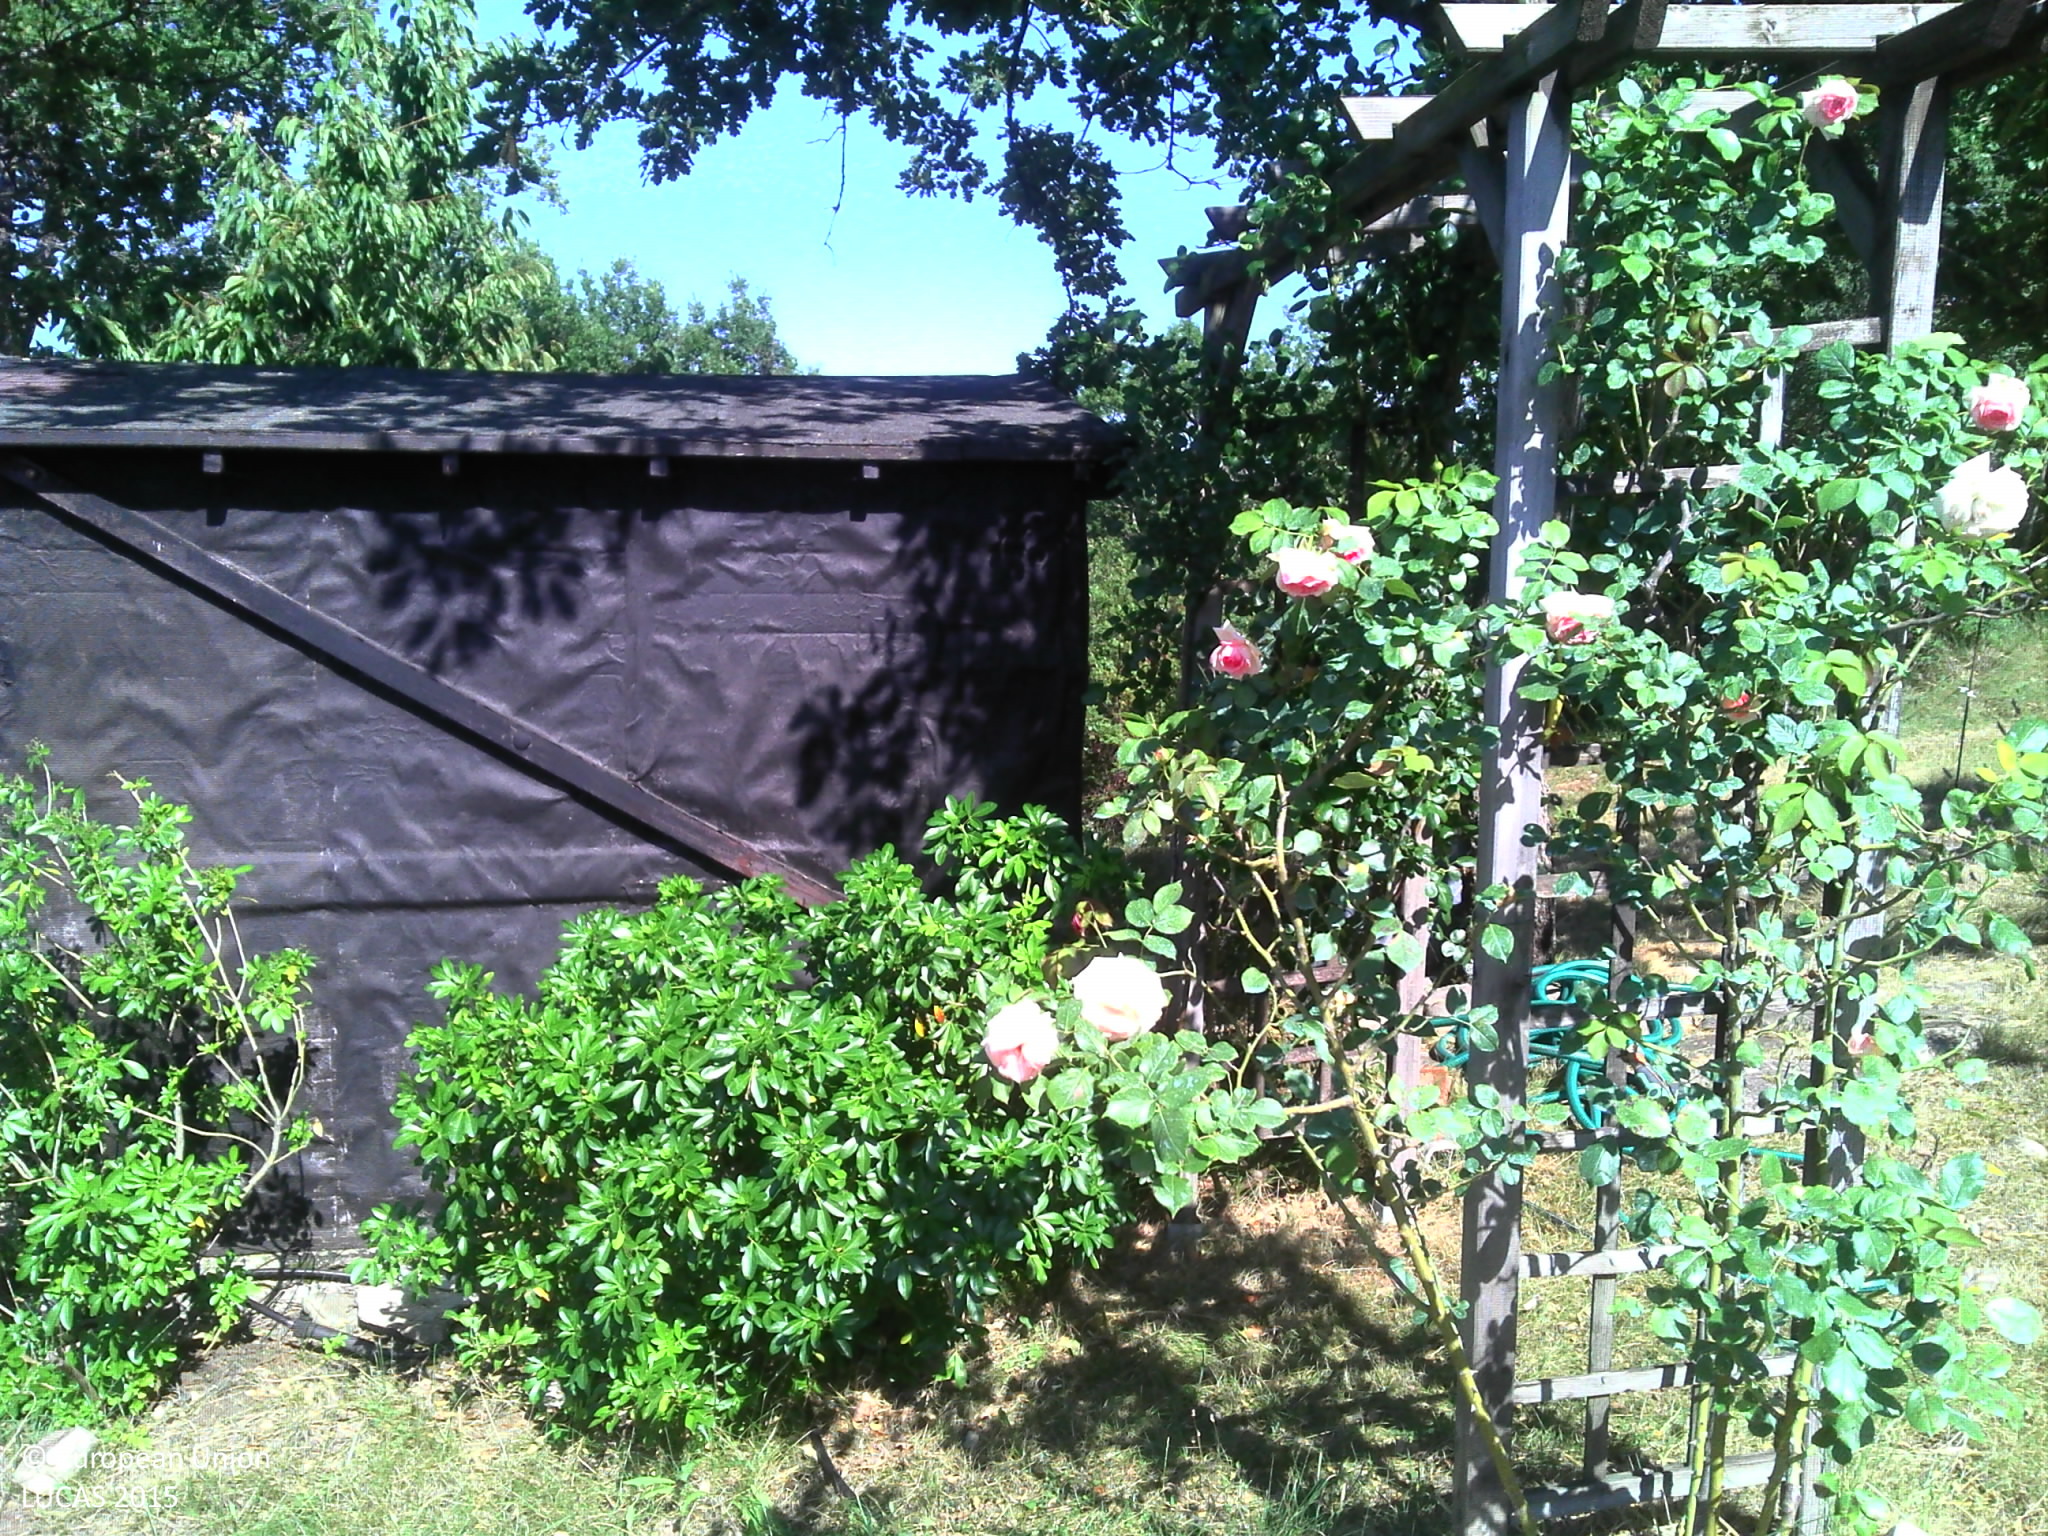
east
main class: Grassland
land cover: Grassland with sparse tree/shrub cover
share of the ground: > 75 %
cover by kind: herbaceous plants 95 %, coniferous forest trees 5 %
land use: Agriculture (excluding fallow land and kitchen gardens)
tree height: > 5 m
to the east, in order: Grassland with sparse tree/shrub cover; Fences; Grassland without tree/shrub cover; Artificial constructions in urban areas; Broadleaved woodland; Tracks; Broadleaved woodland; Shrubland with sparse tree cover
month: July
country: FR
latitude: 42.9297
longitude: 2.1550
